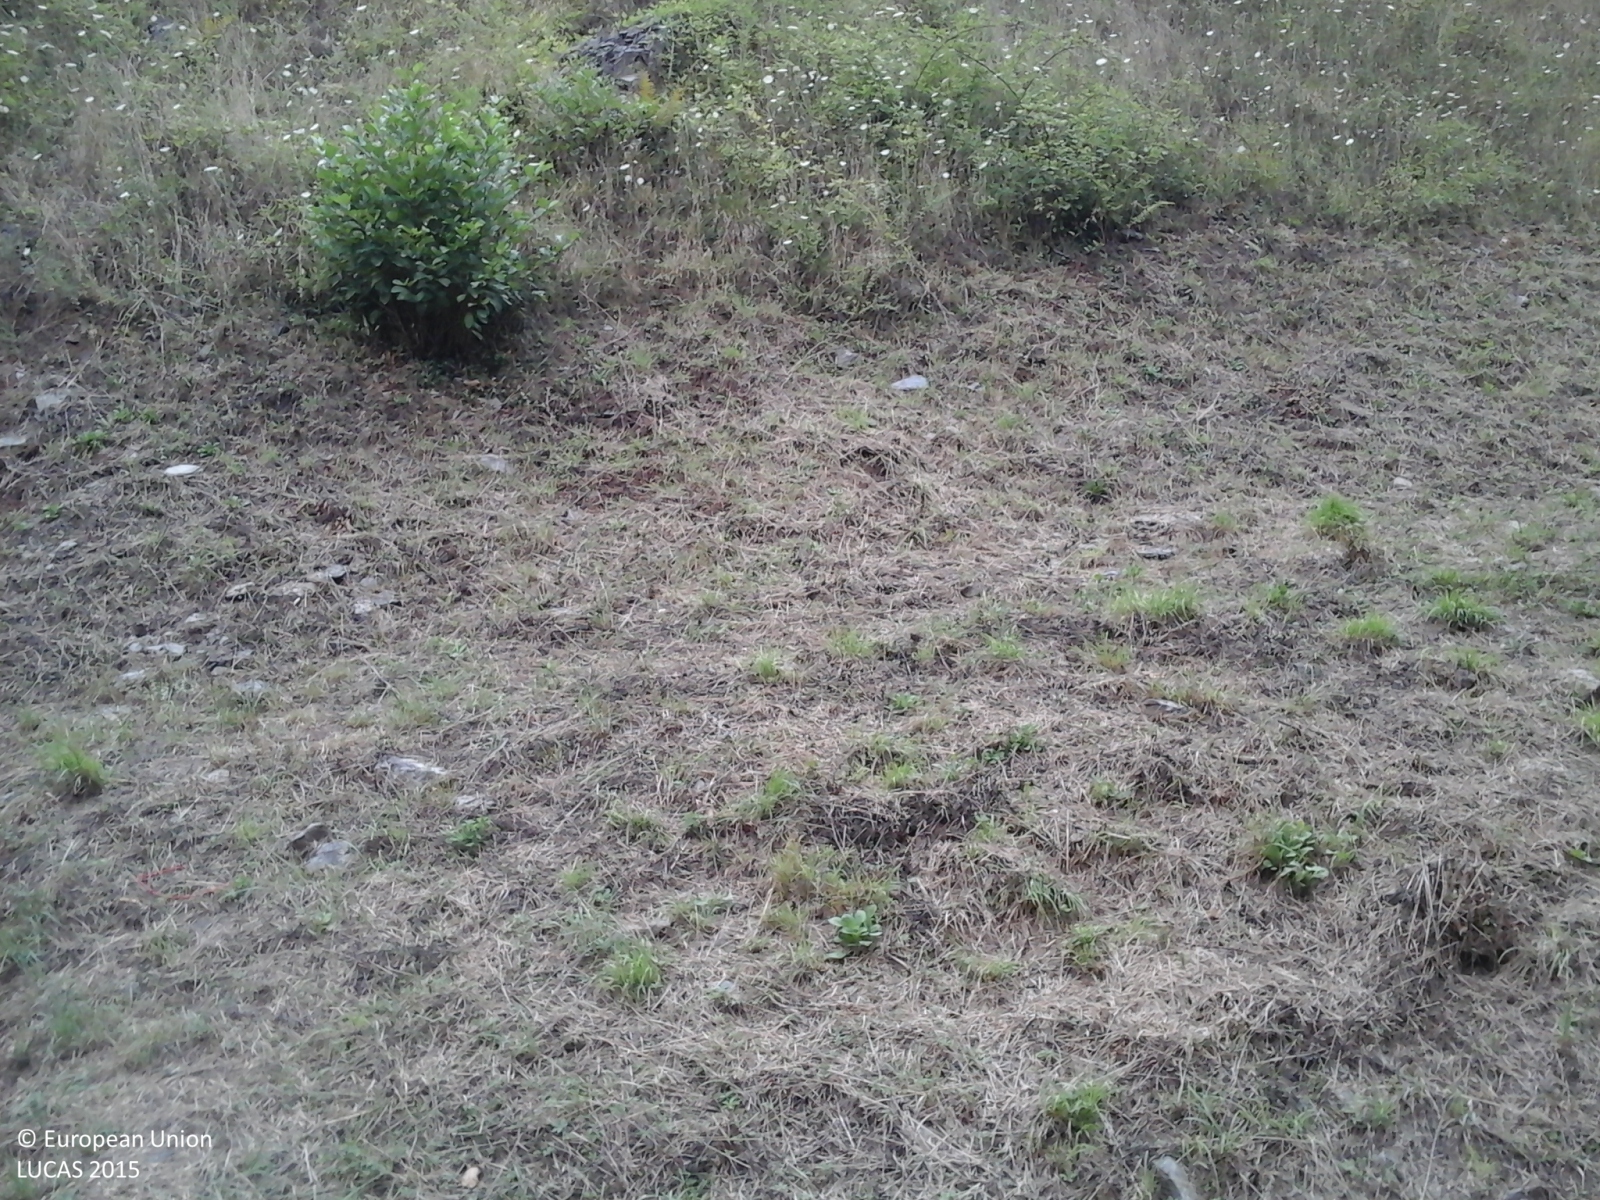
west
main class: Woodland
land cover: Broadleaved woodland
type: thermophilous deciduous forest
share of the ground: > 75 %
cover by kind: broadleaved forest trees 100 %
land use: Forestry
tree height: > 5 m
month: August
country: IT
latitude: 44.0074
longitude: 10.3110
